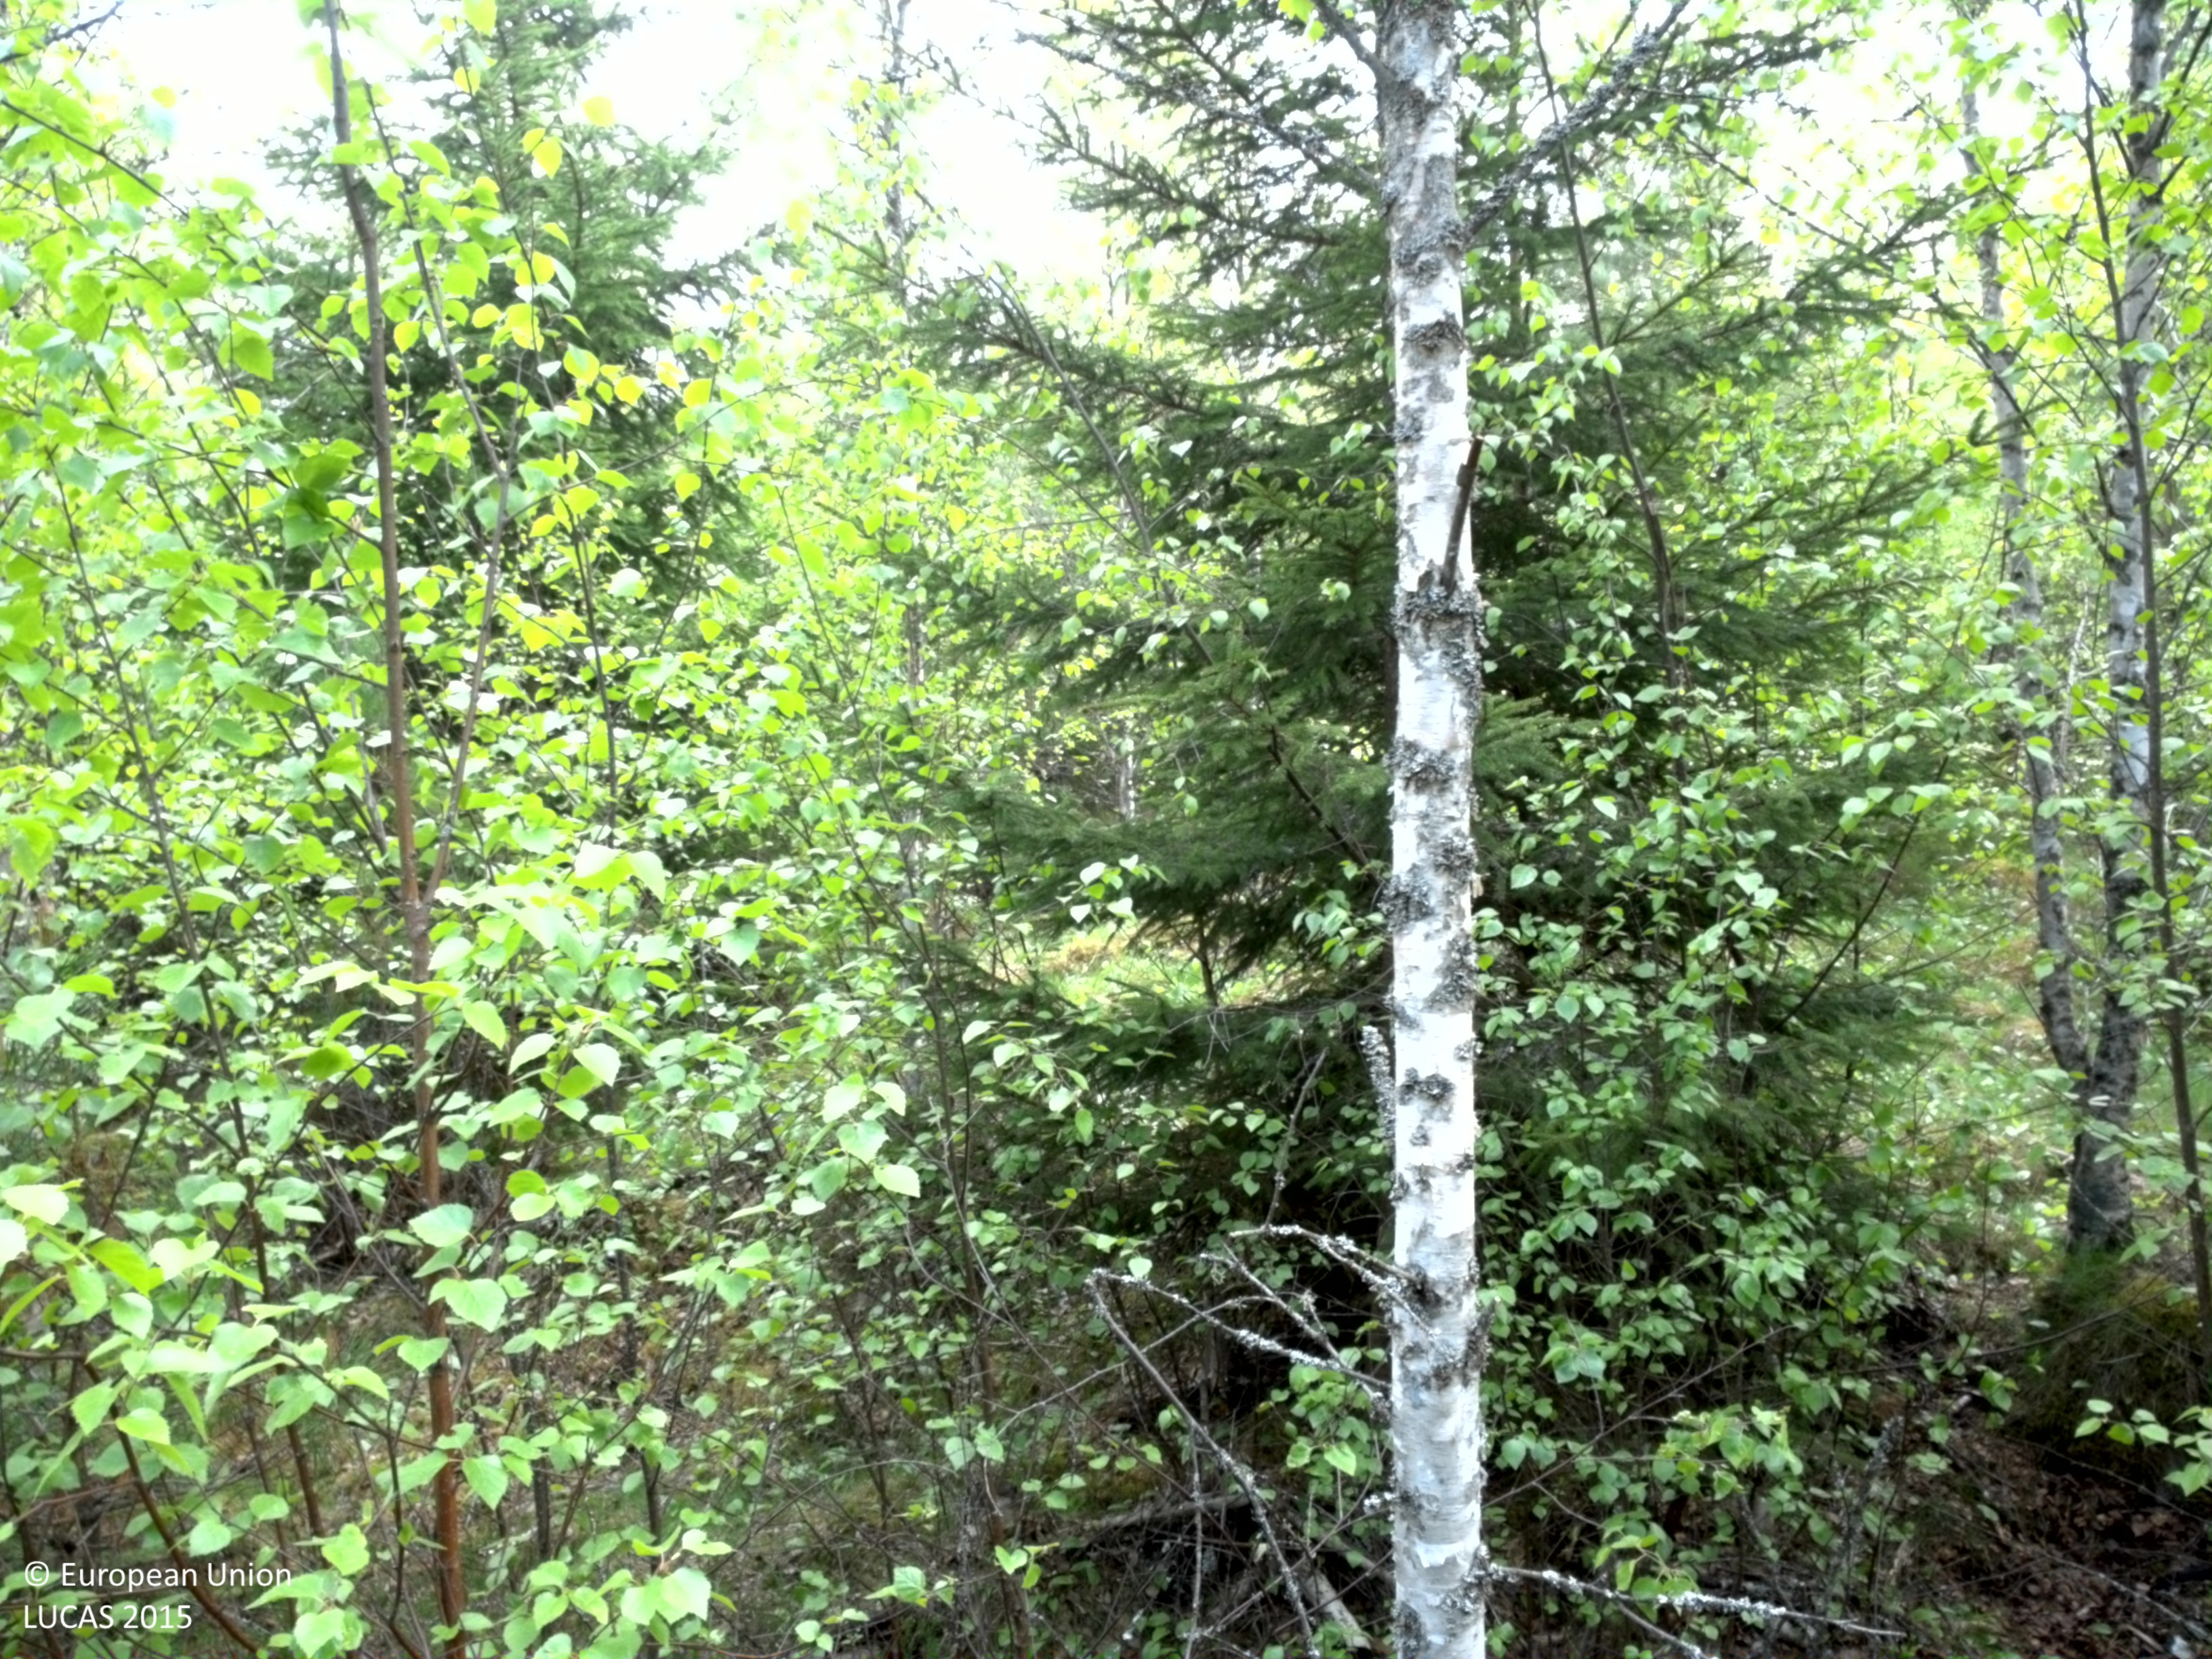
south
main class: Woodland
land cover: Broadleaved woodland
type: boreal forest
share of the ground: 50 - 75 %
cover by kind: broadleaved forest trees 60 %, coniferous forest trees 10 %, shrubs 10 %, herbaceous plants 10 %, lichens and mosses 10 %
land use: Forestry
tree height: > 5 m
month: May
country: SE
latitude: 57.2760
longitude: 15.9525
